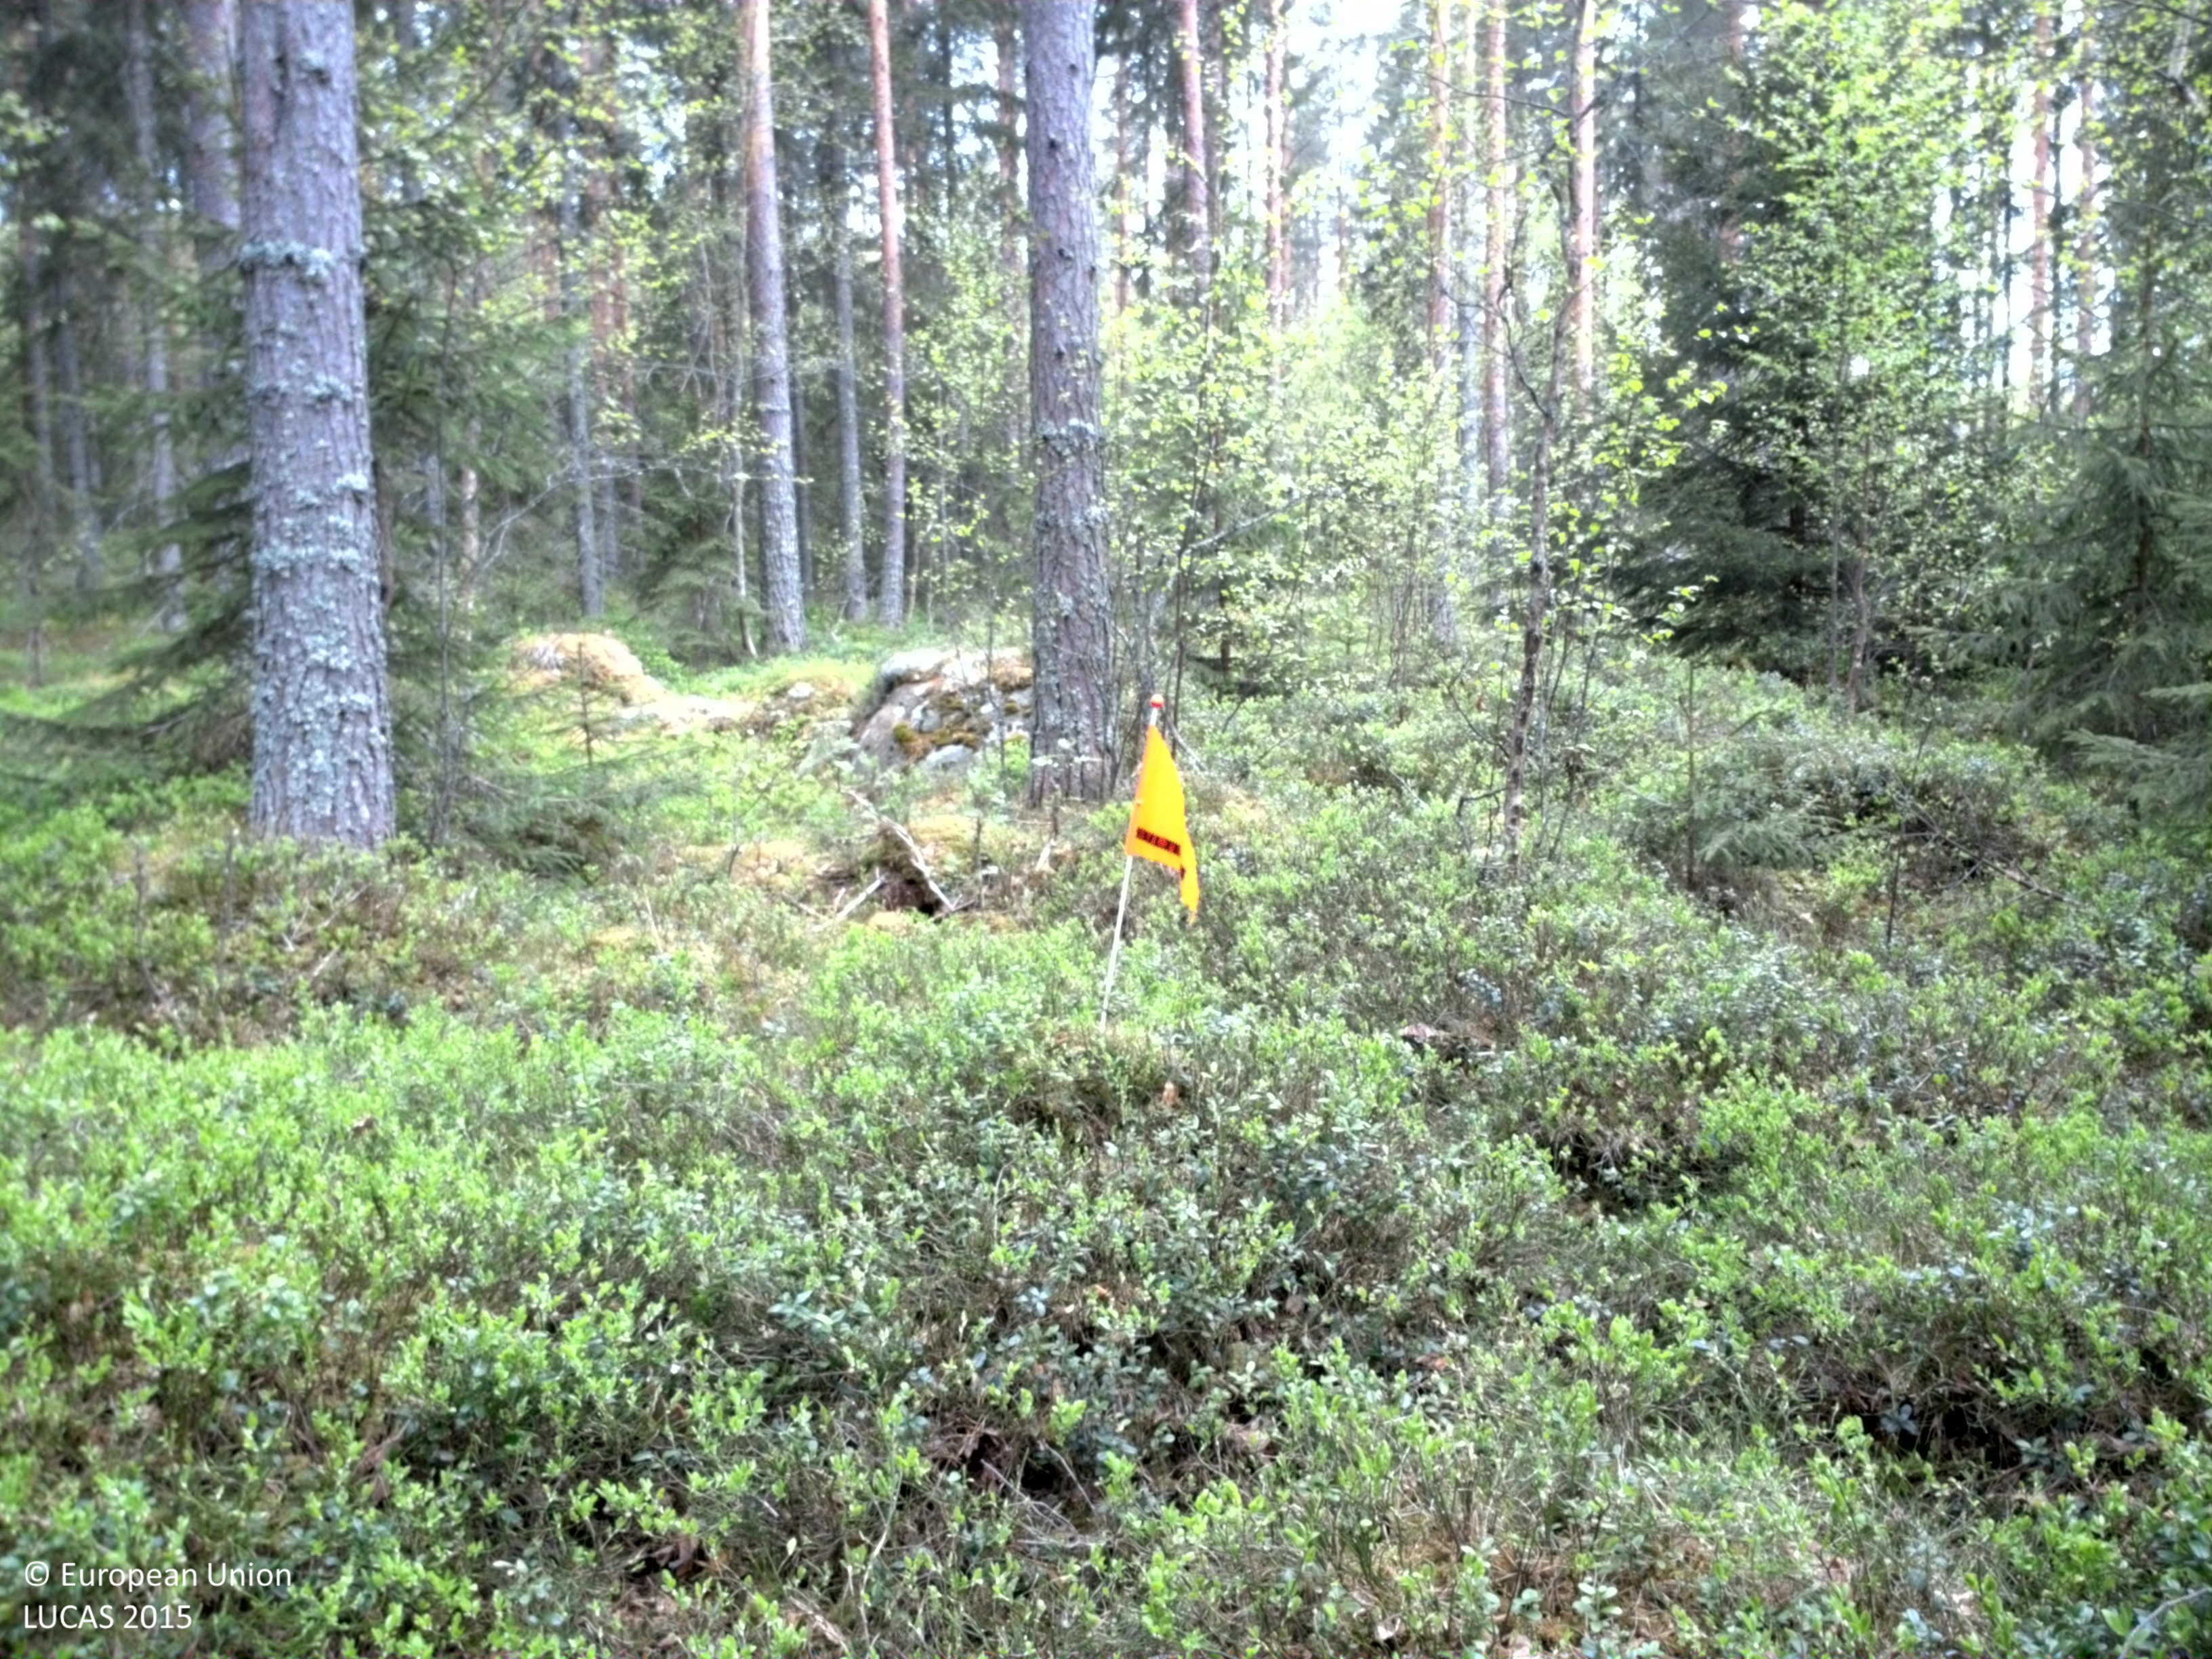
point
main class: Woodland
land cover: Pine dominated coniferous woodland
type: boreal forest
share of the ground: 50 - 75 %
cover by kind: coniferous forest trees 60 %, shrubs 30 %, broadleaved forest trees 10 %
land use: Forestry
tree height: > 5 m
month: May
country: SE
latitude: 61.1966
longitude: 15.3995
